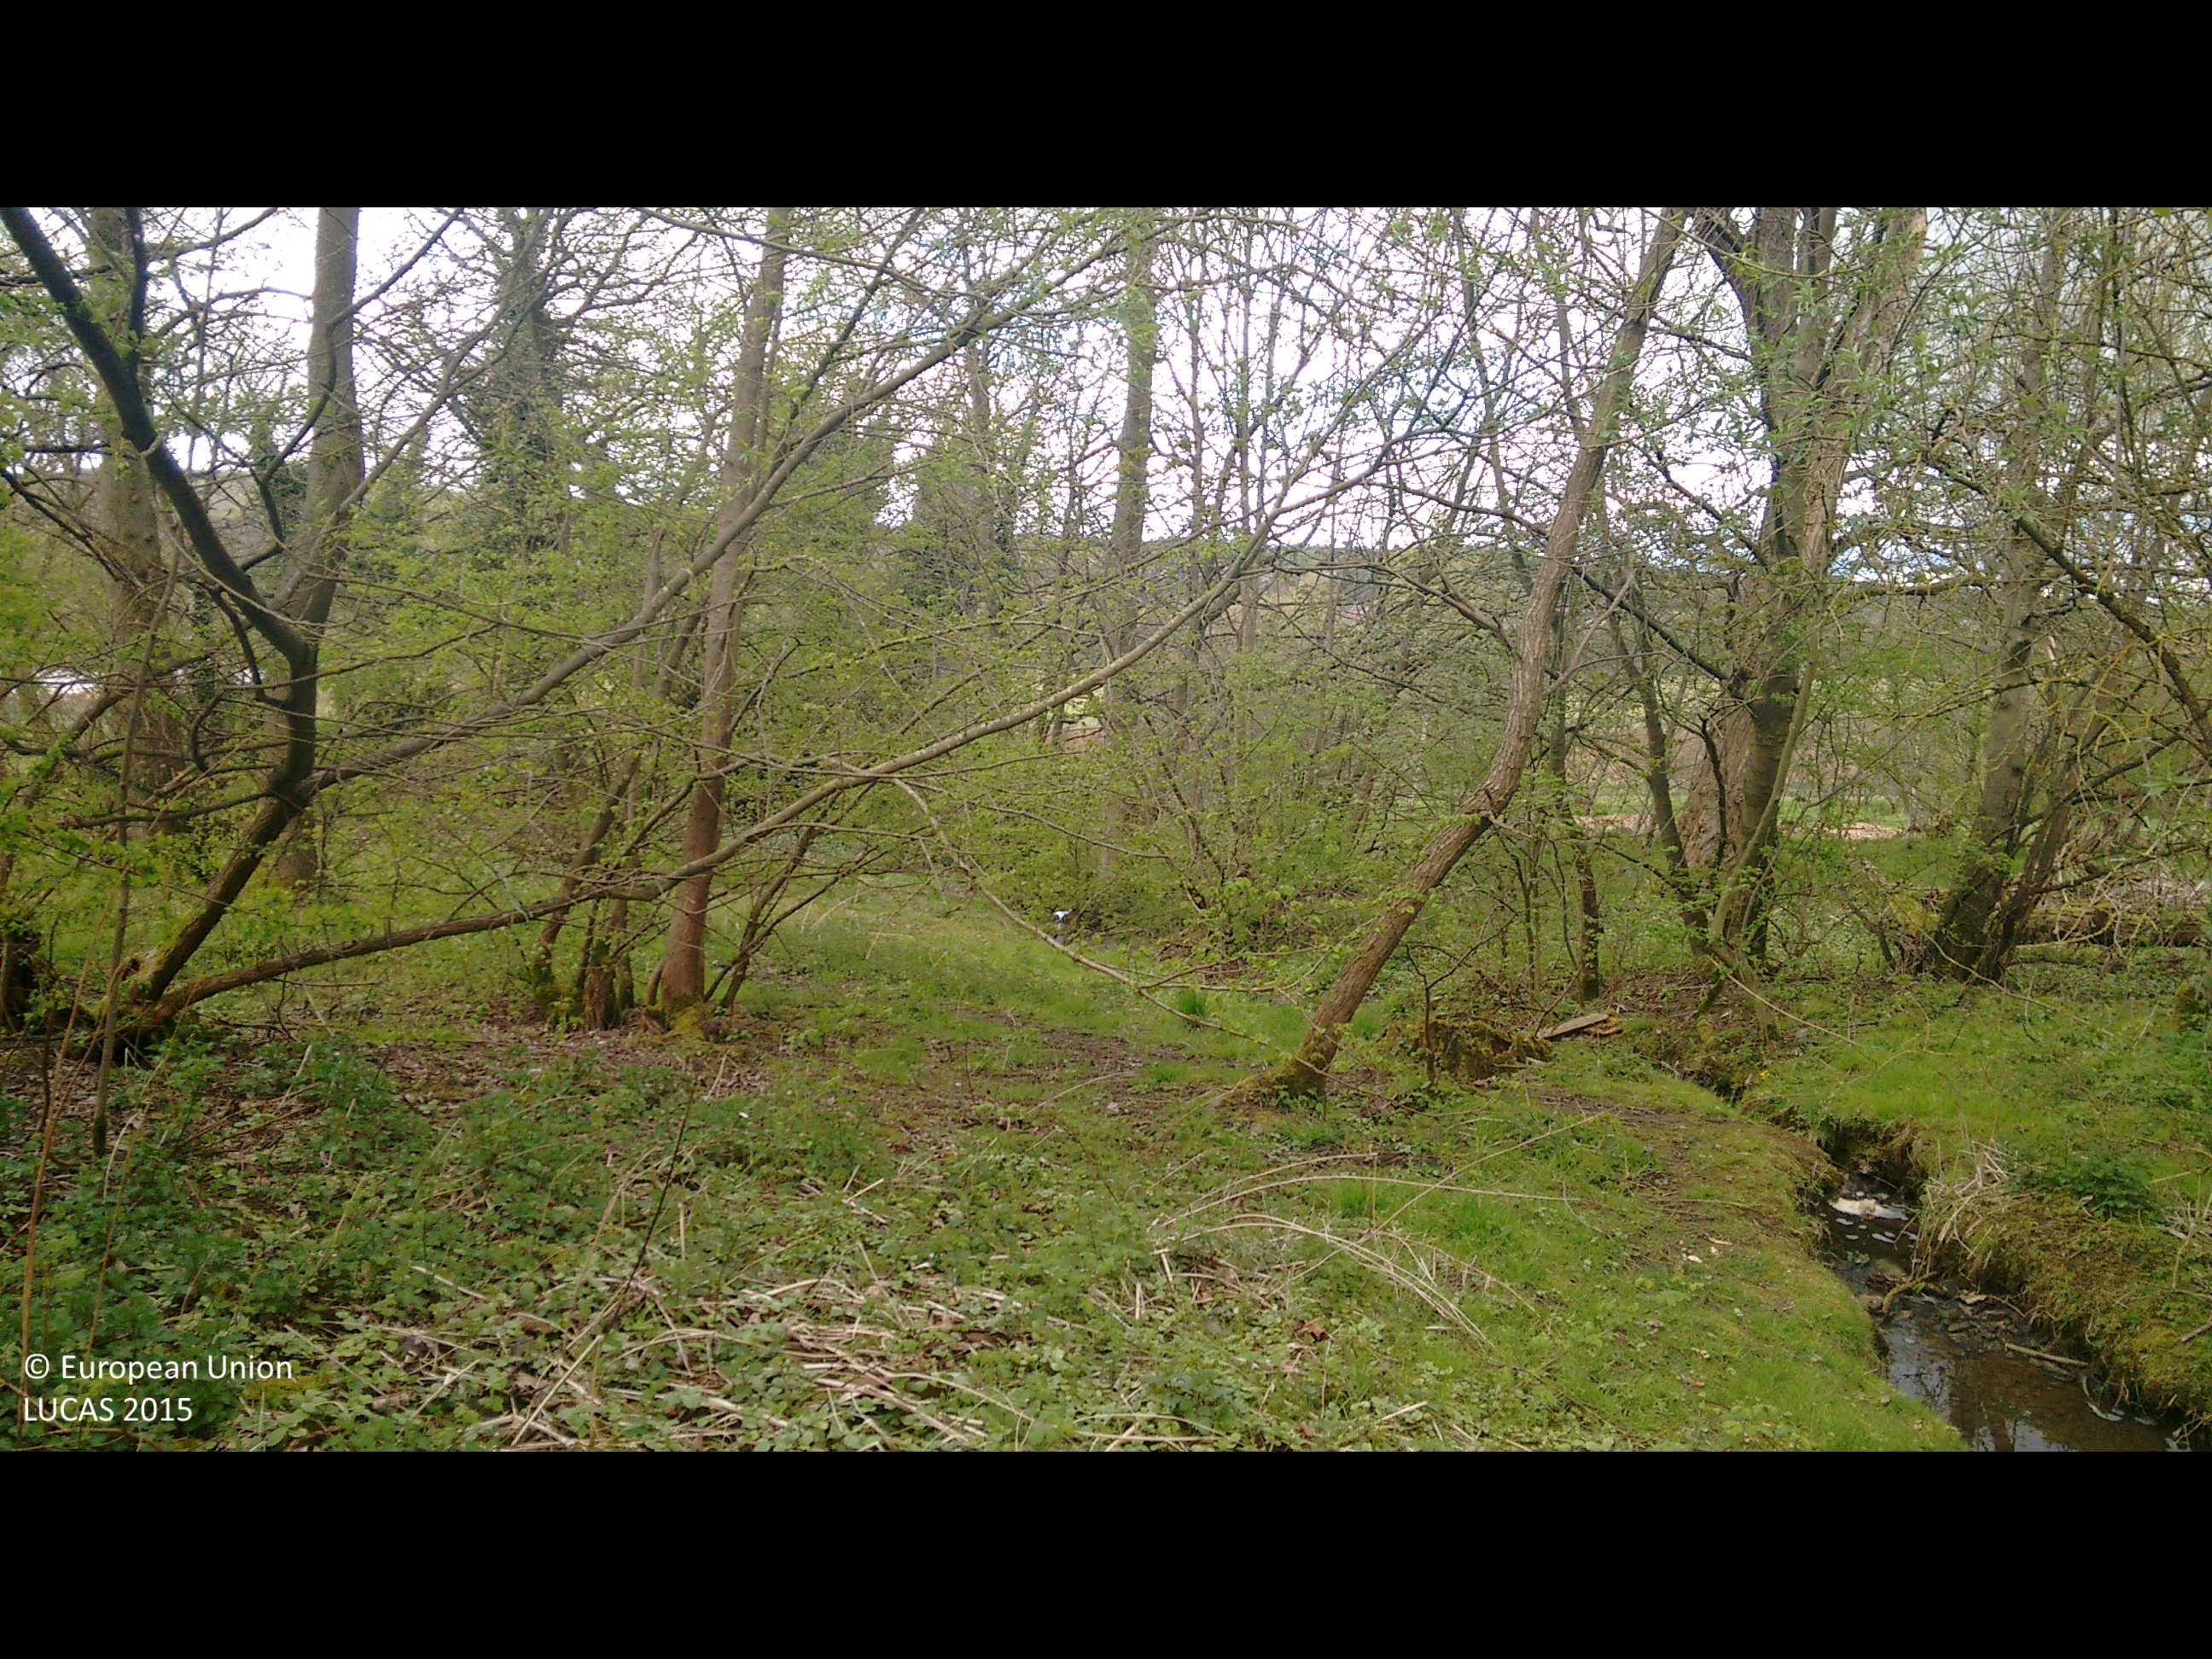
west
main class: Woodland
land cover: Pine dominated mixed woodland
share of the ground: > 75 %
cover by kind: coniferous forest trees 75 %, broadleaved forest trees 25 %
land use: Semi-natural and natural areas not in use
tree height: > 5 m
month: April
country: GB
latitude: 53.7812
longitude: -2.2165
